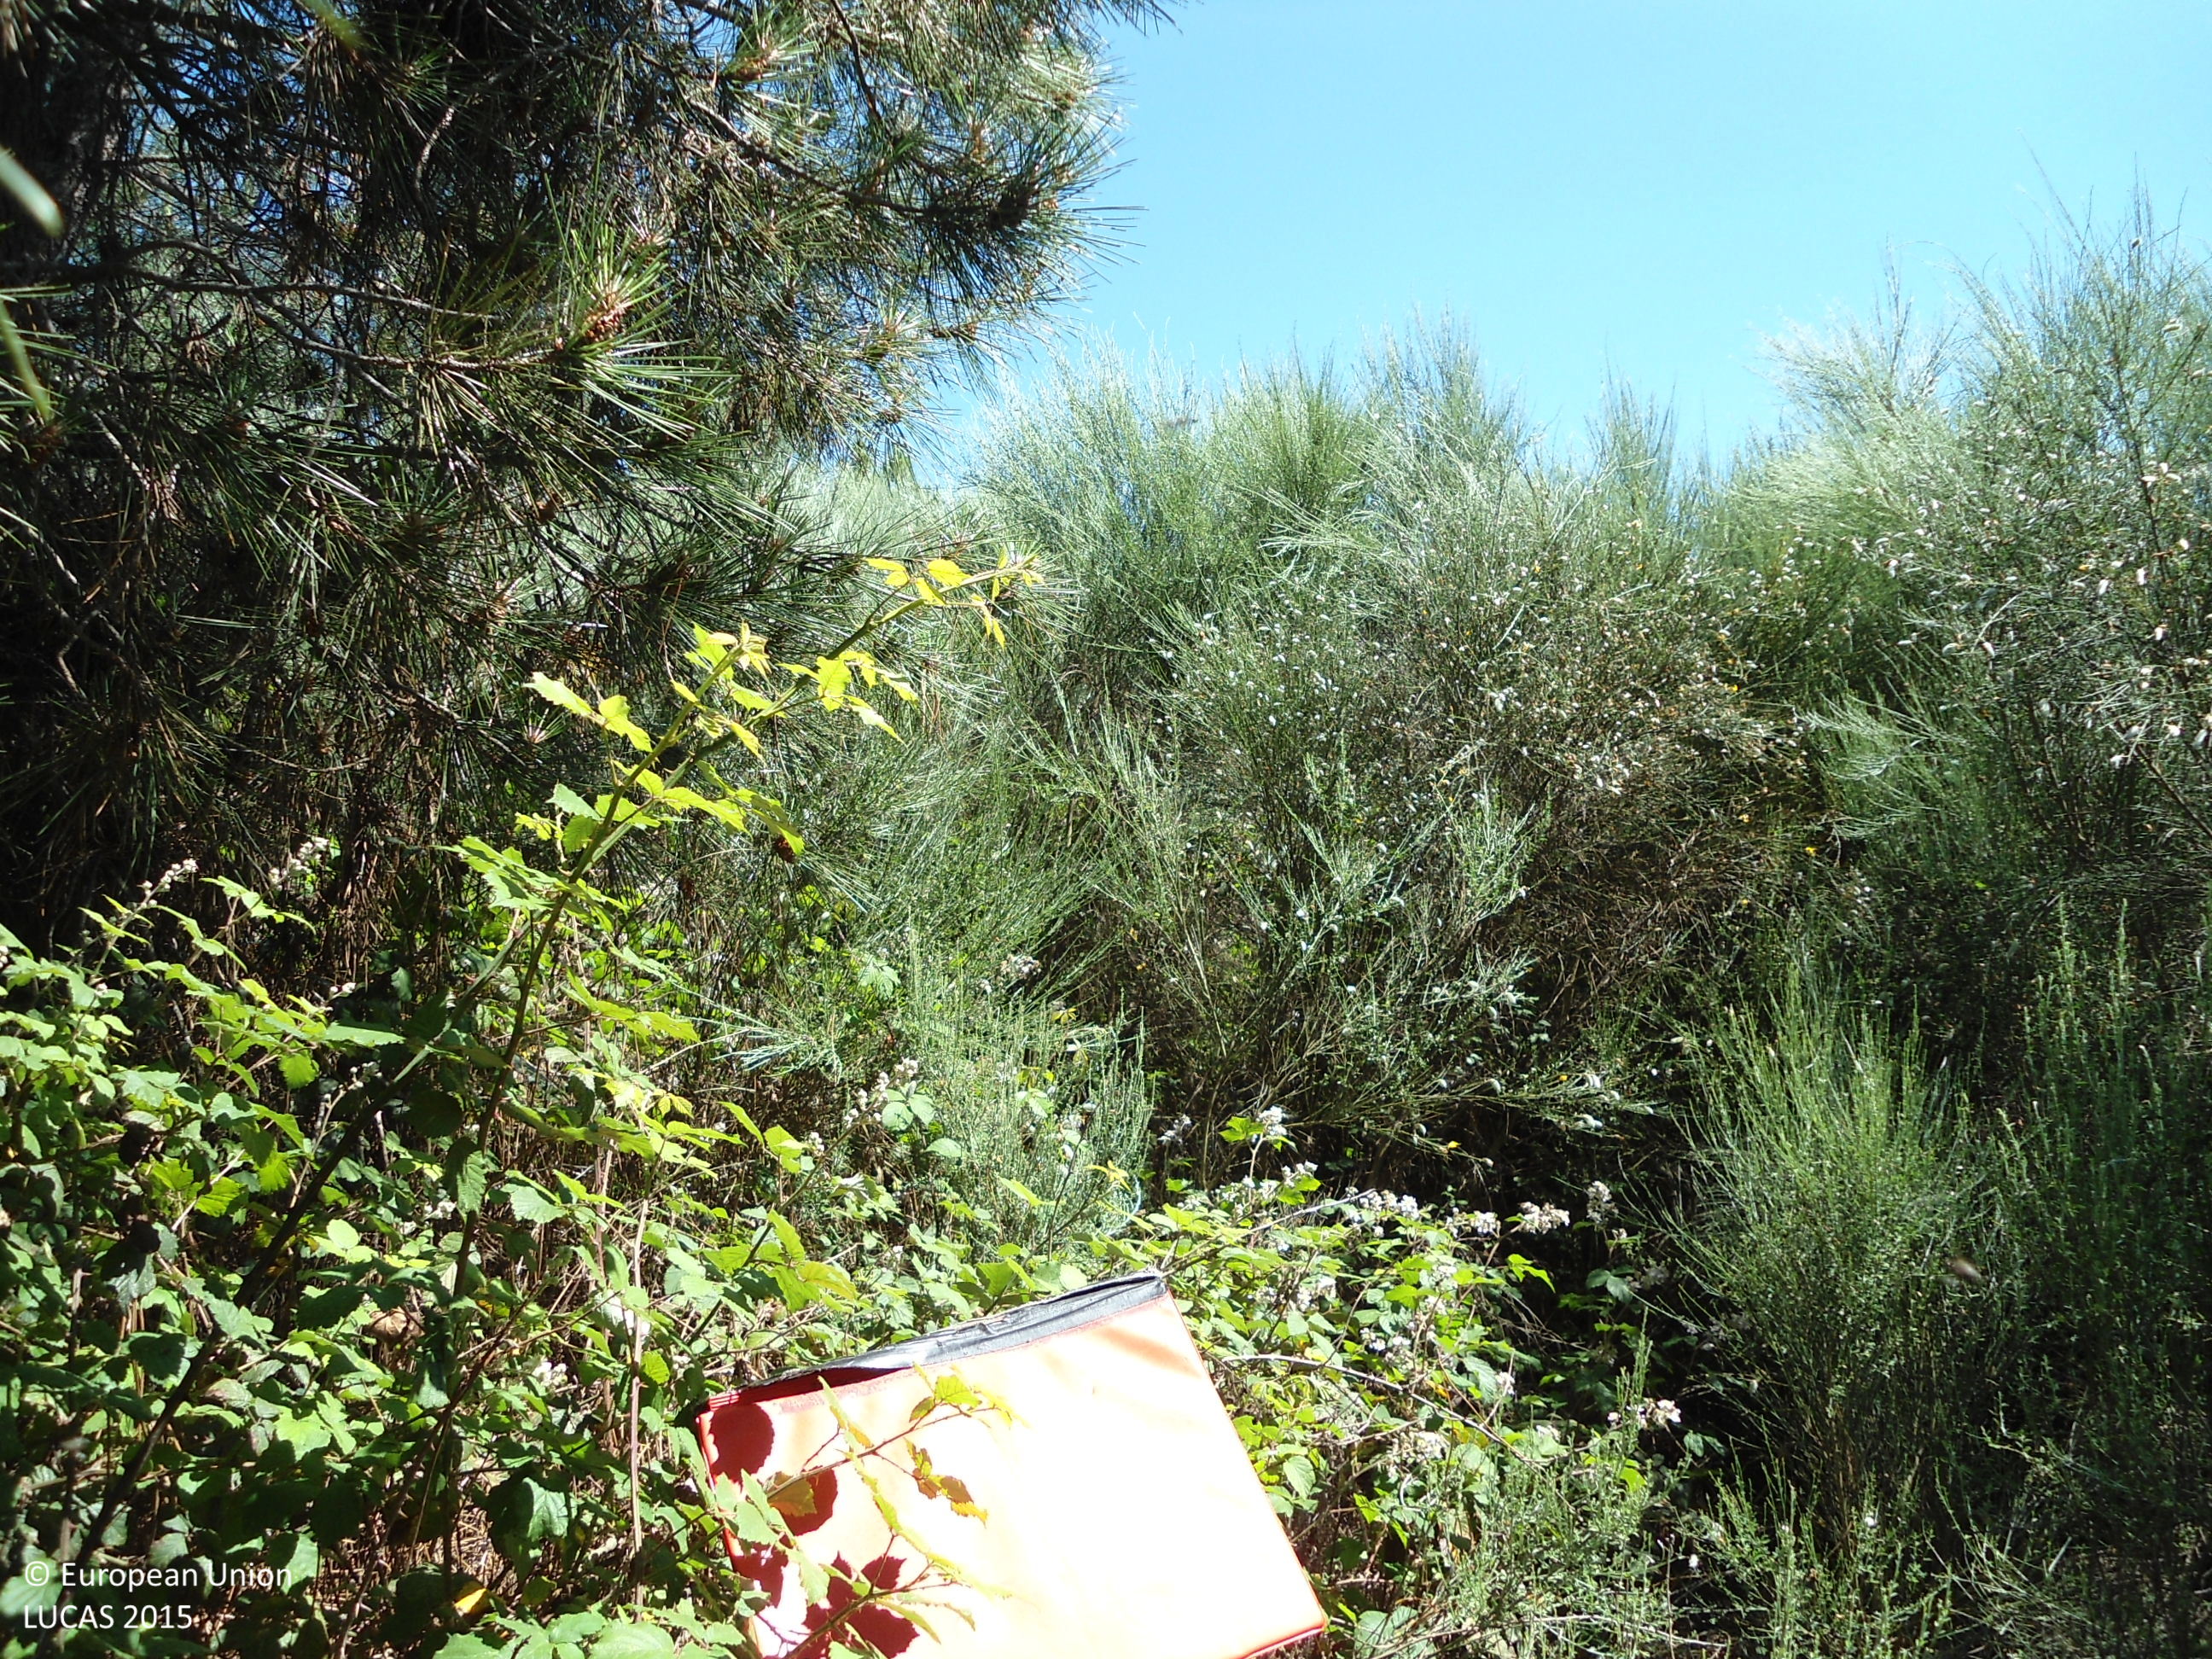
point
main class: Woodland
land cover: Pine dominated coniferous woodland
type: coniferous forest of the mediterranean region
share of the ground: 25 - 50 %
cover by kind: shrubs 70 %, coniferous forest trees 30 %
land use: Forestry
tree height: > 5 m
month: June
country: ES
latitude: 41.9146
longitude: -7.2598
